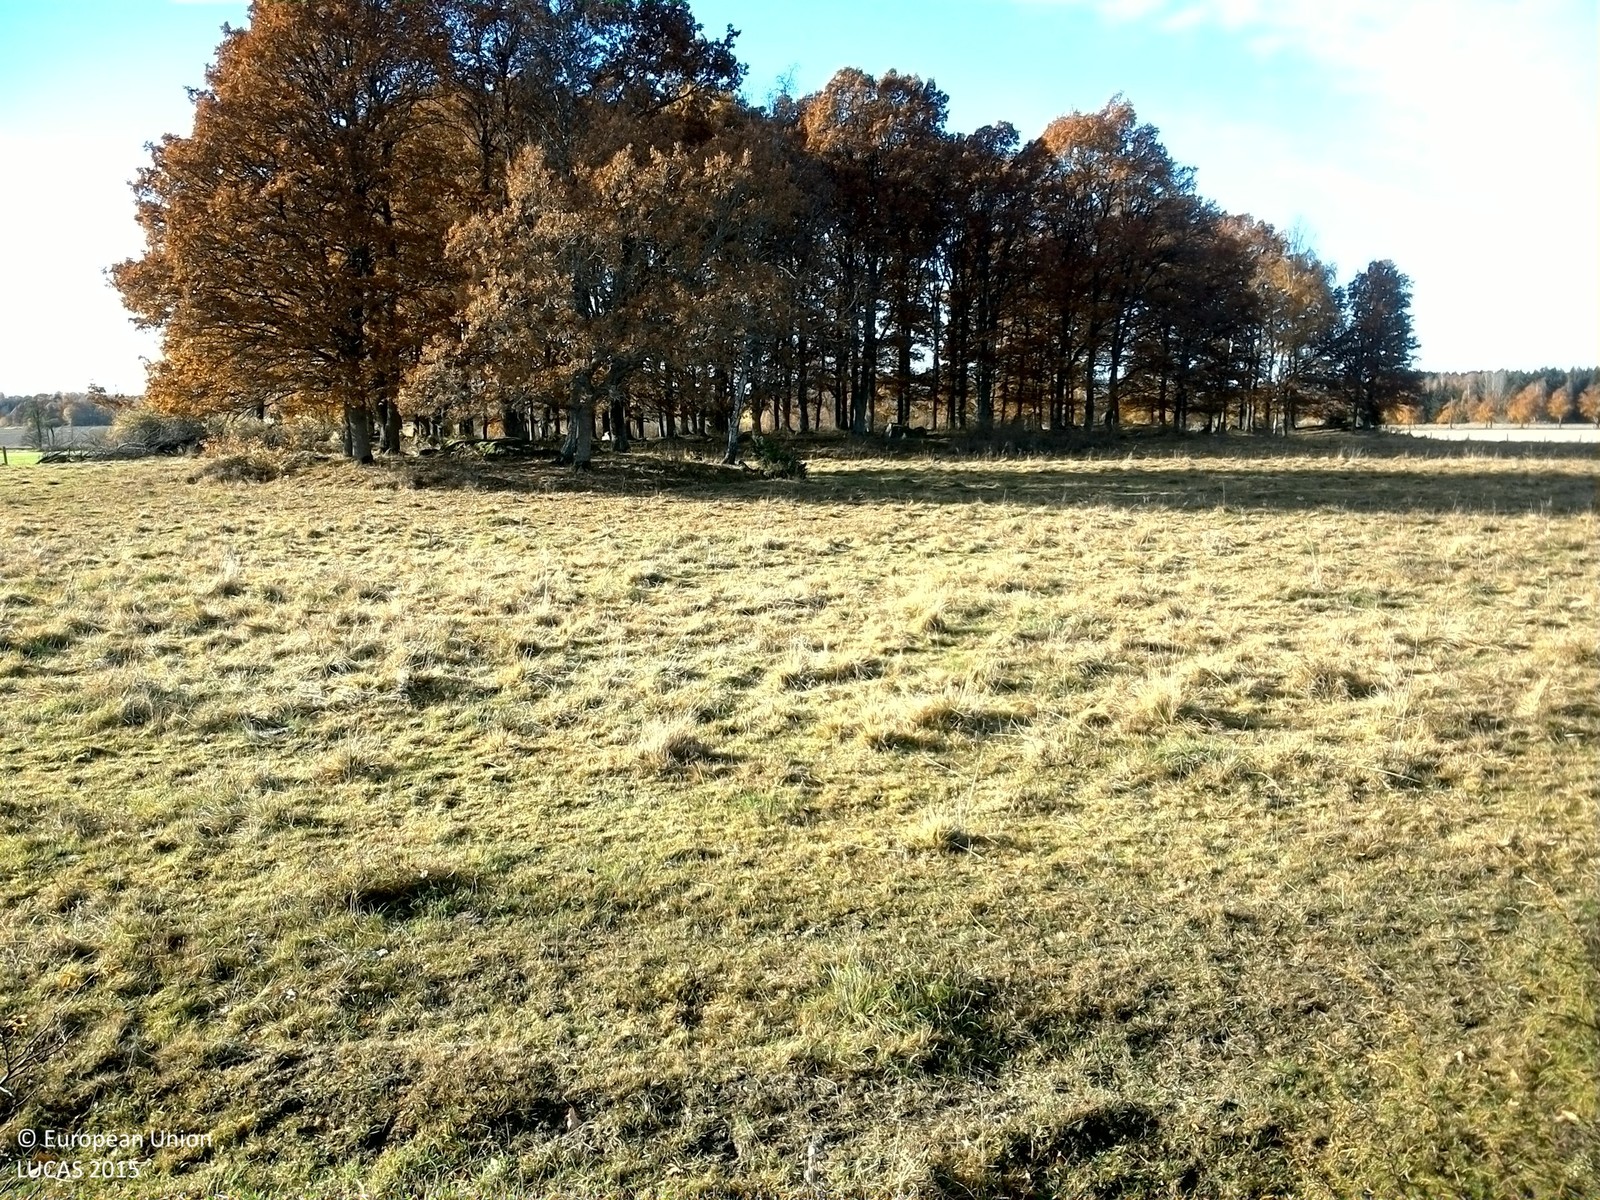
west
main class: Shrubland
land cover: Shrubland with sparse tree cover
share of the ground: 50 - 75 %
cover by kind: shrubs 50 %, herbaceous plants 35 %, consolidated bare surface 10 %, broadleaved forest trees 5 %
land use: Agriculture (excluding fallow land and kitchen gardens)
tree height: < 5 m
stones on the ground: < 10 %
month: October
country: SE
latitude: 59.5535
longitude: 16.2726
